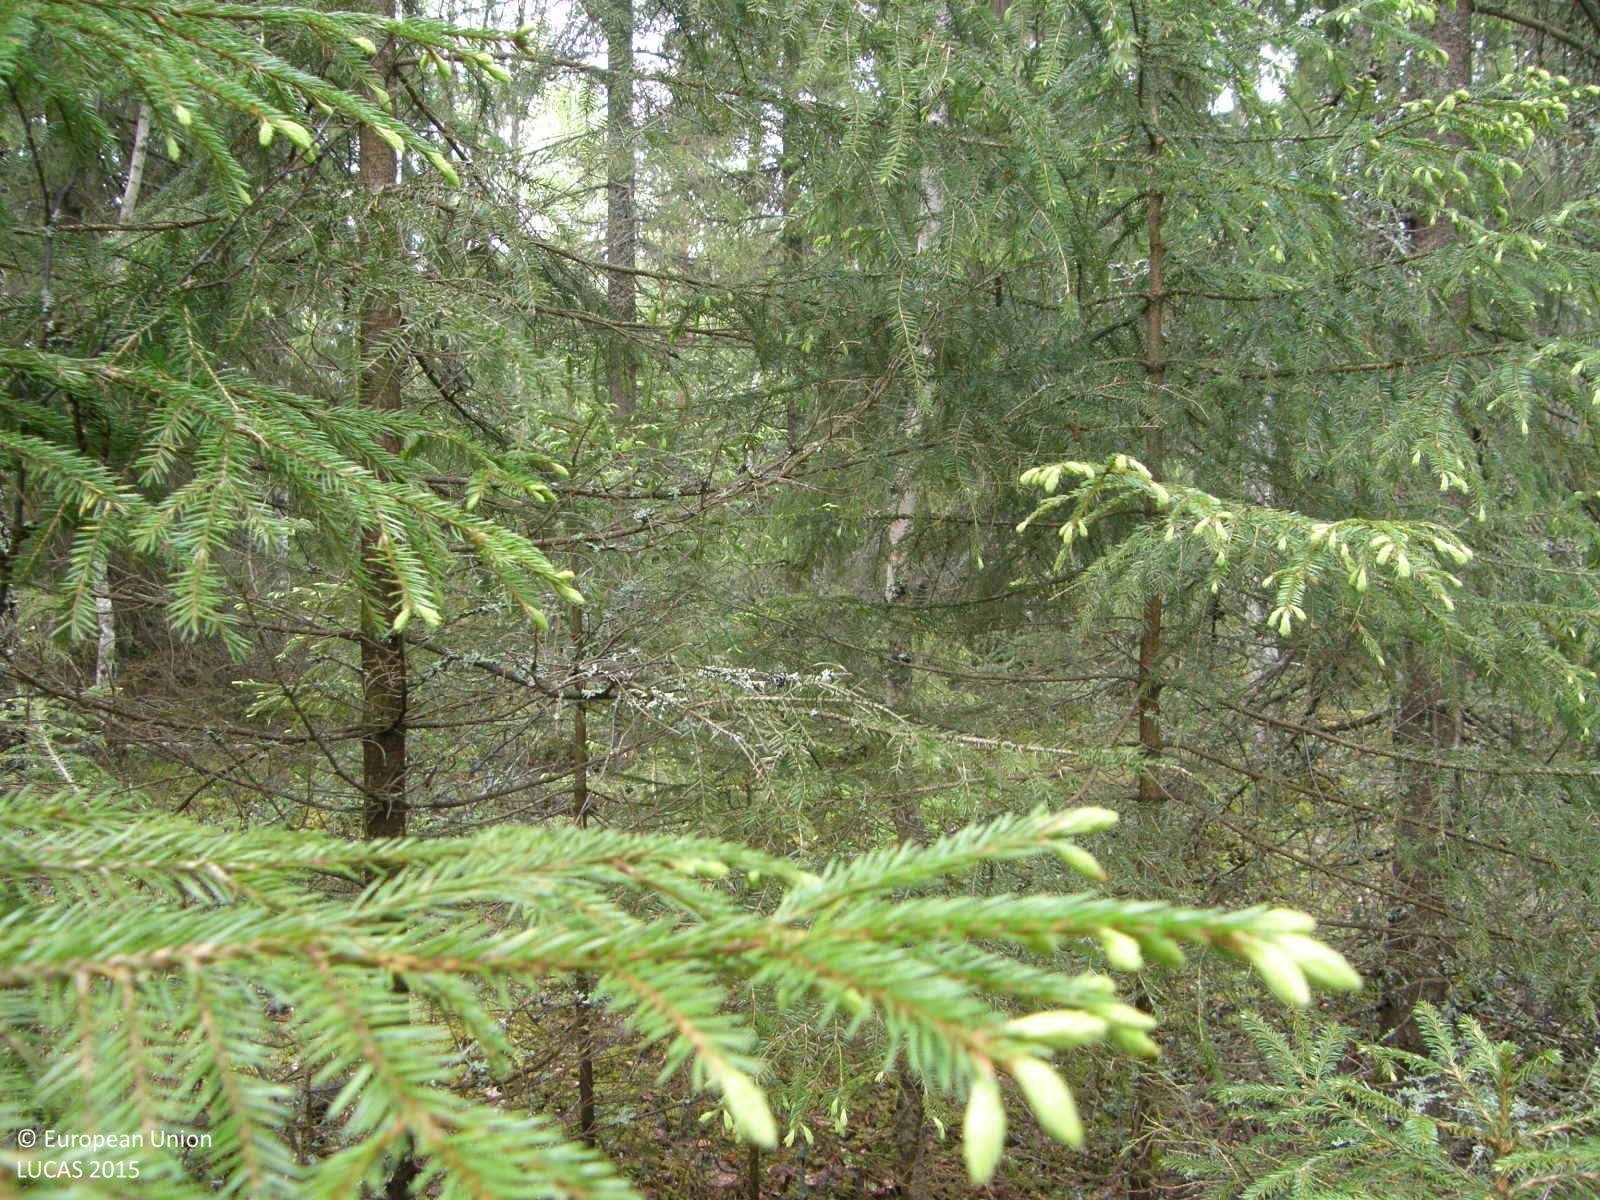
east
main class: Woodland
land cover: Other mixed woodland
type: boreal forest
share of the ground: > 75 %
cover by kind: coniferous forest trees 60 %, broadleaved forest trees 25 %, shrubs 15 %
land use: Forestry
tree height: > 5 m
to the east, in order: Other mixed woodland; Ditches and canals; Other mixed woodland; Ditches and canals; Pine dominated mixed woodland; Ditches and canals; Pine dominated coniferous woodland; Ditches and canals; Pine dominated coniferous woodland; Ditches and canals; Electric lines; Other mixed woodland; Rivers and streams; Broadleaved woodland; Ditches and canals; Broadleaved woodland
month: June
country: FI
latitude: 62.0395
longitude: 21.7695
